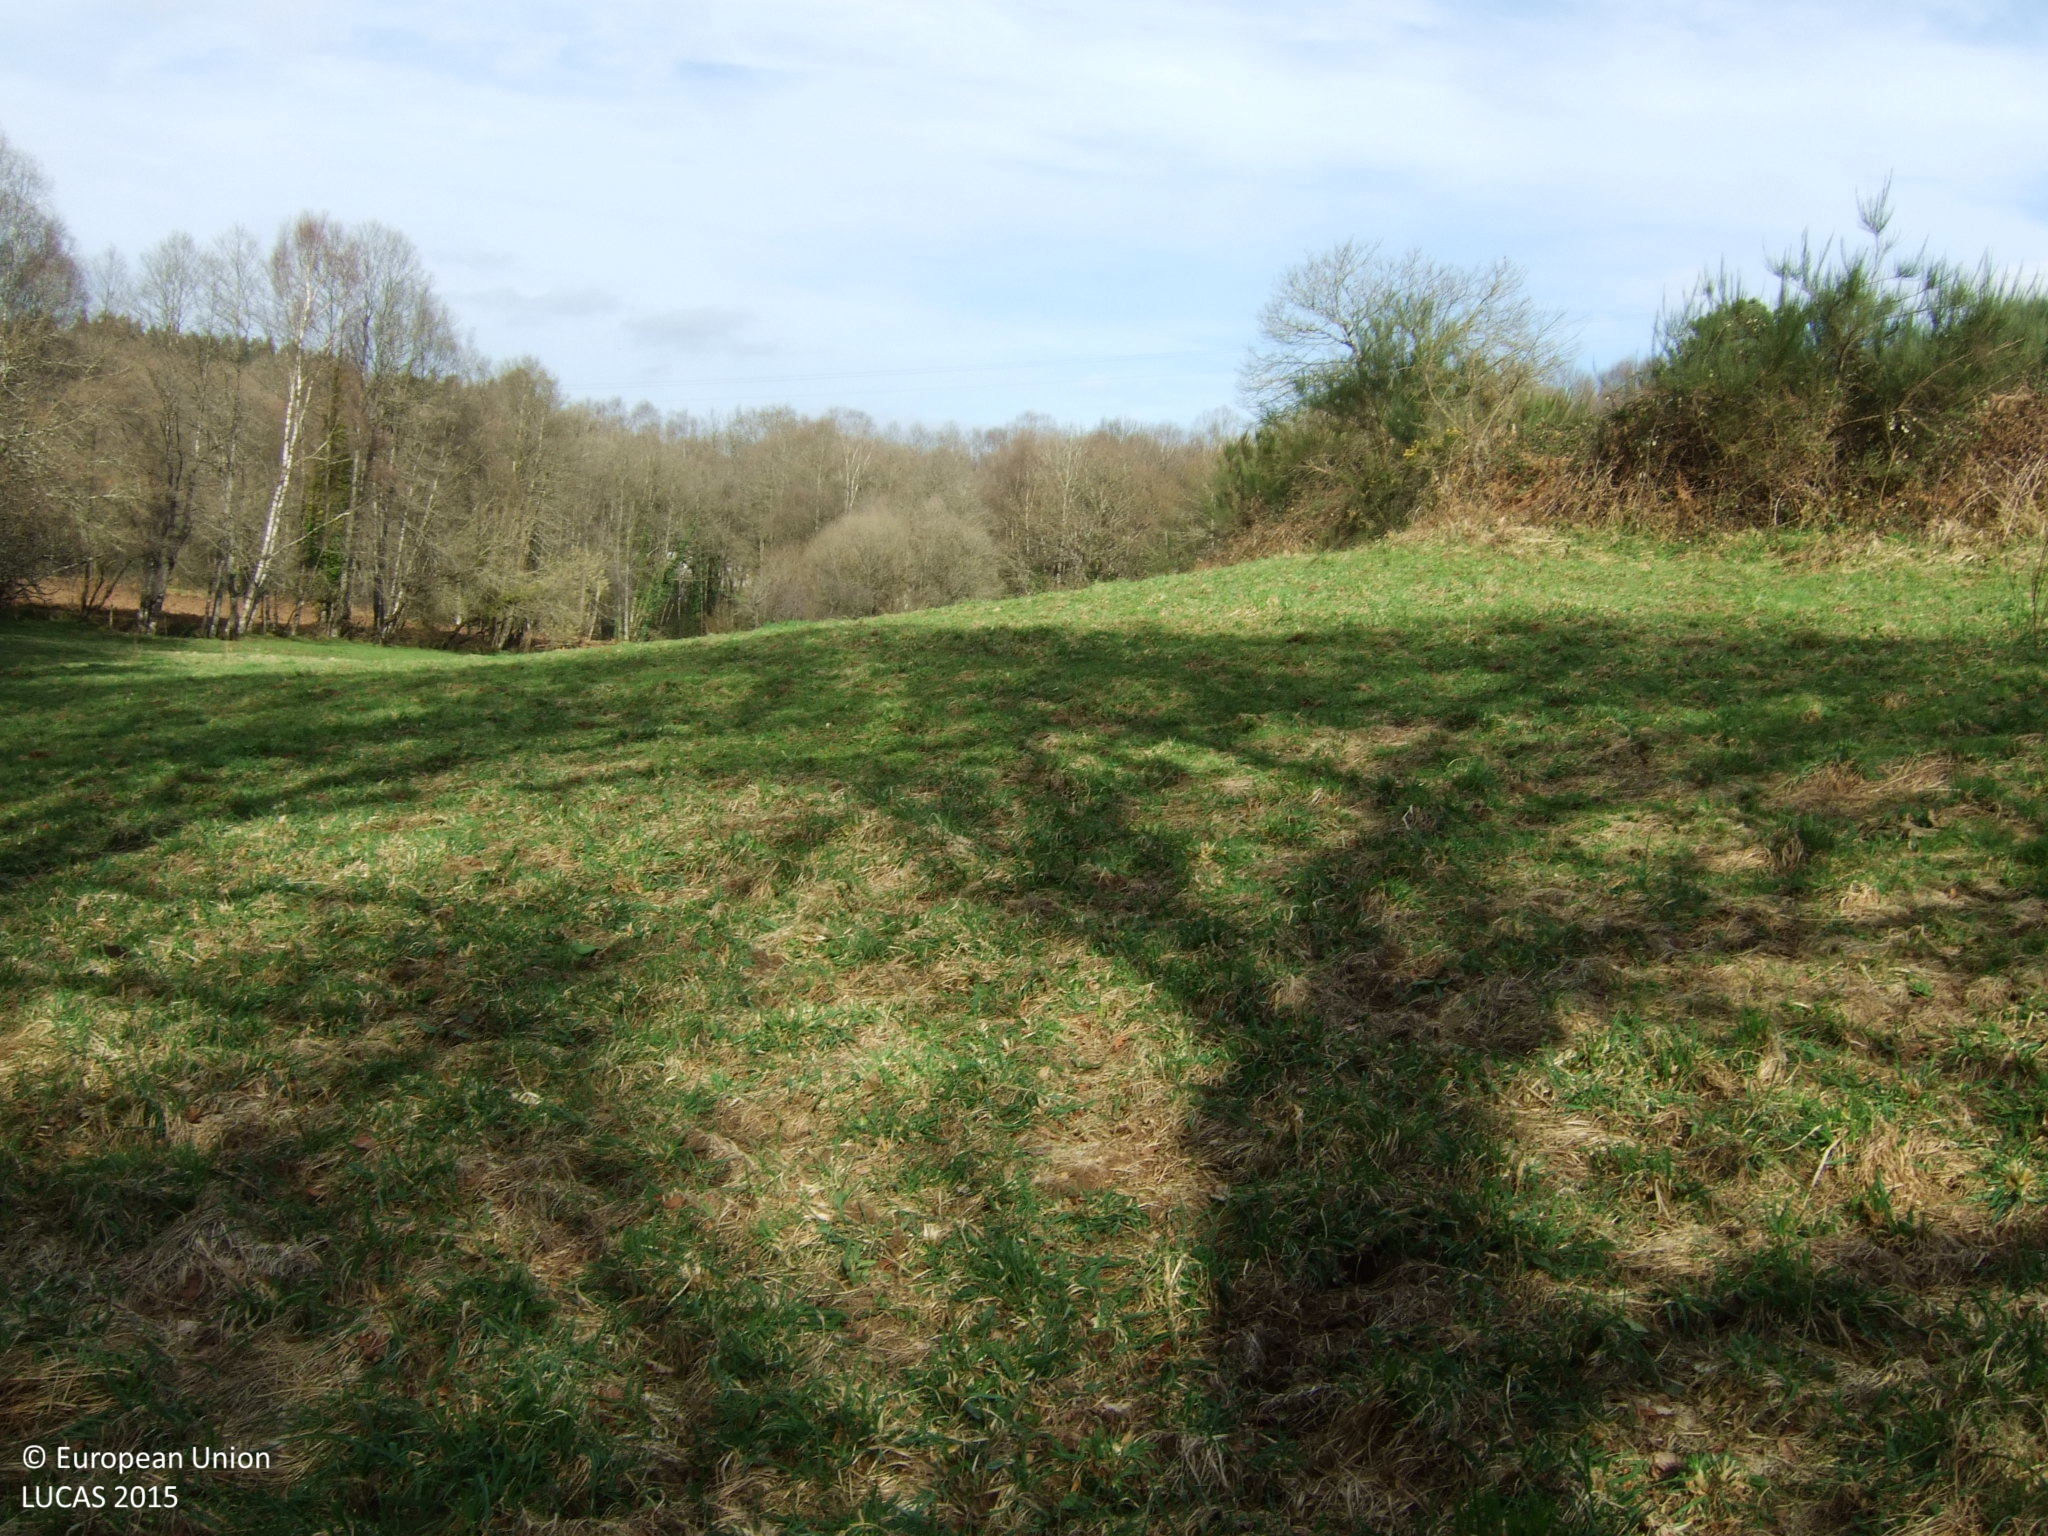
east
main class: Grassland
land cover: Grassland without tree/shrub cover
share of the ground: > 75 %
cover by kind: herbaceous plants 100 %
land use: Agriculture (excluding fallow land and kitchen gardens)
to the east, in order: Grassland without tree/shrub cover; Shruby margins; Grassland without tree/shrub cover; Electric lines; Grassland without tree/shrub cover; Dry stone walls; Broadleaved woodland; Dry stone walls; Paved roads, cycling and walking lanes; Dry stone walls; Shruby margins; Grassland without tree/shrub cover; Broadleaved woodland
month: March
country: ES
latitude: 42.9408
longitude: -7.8167
